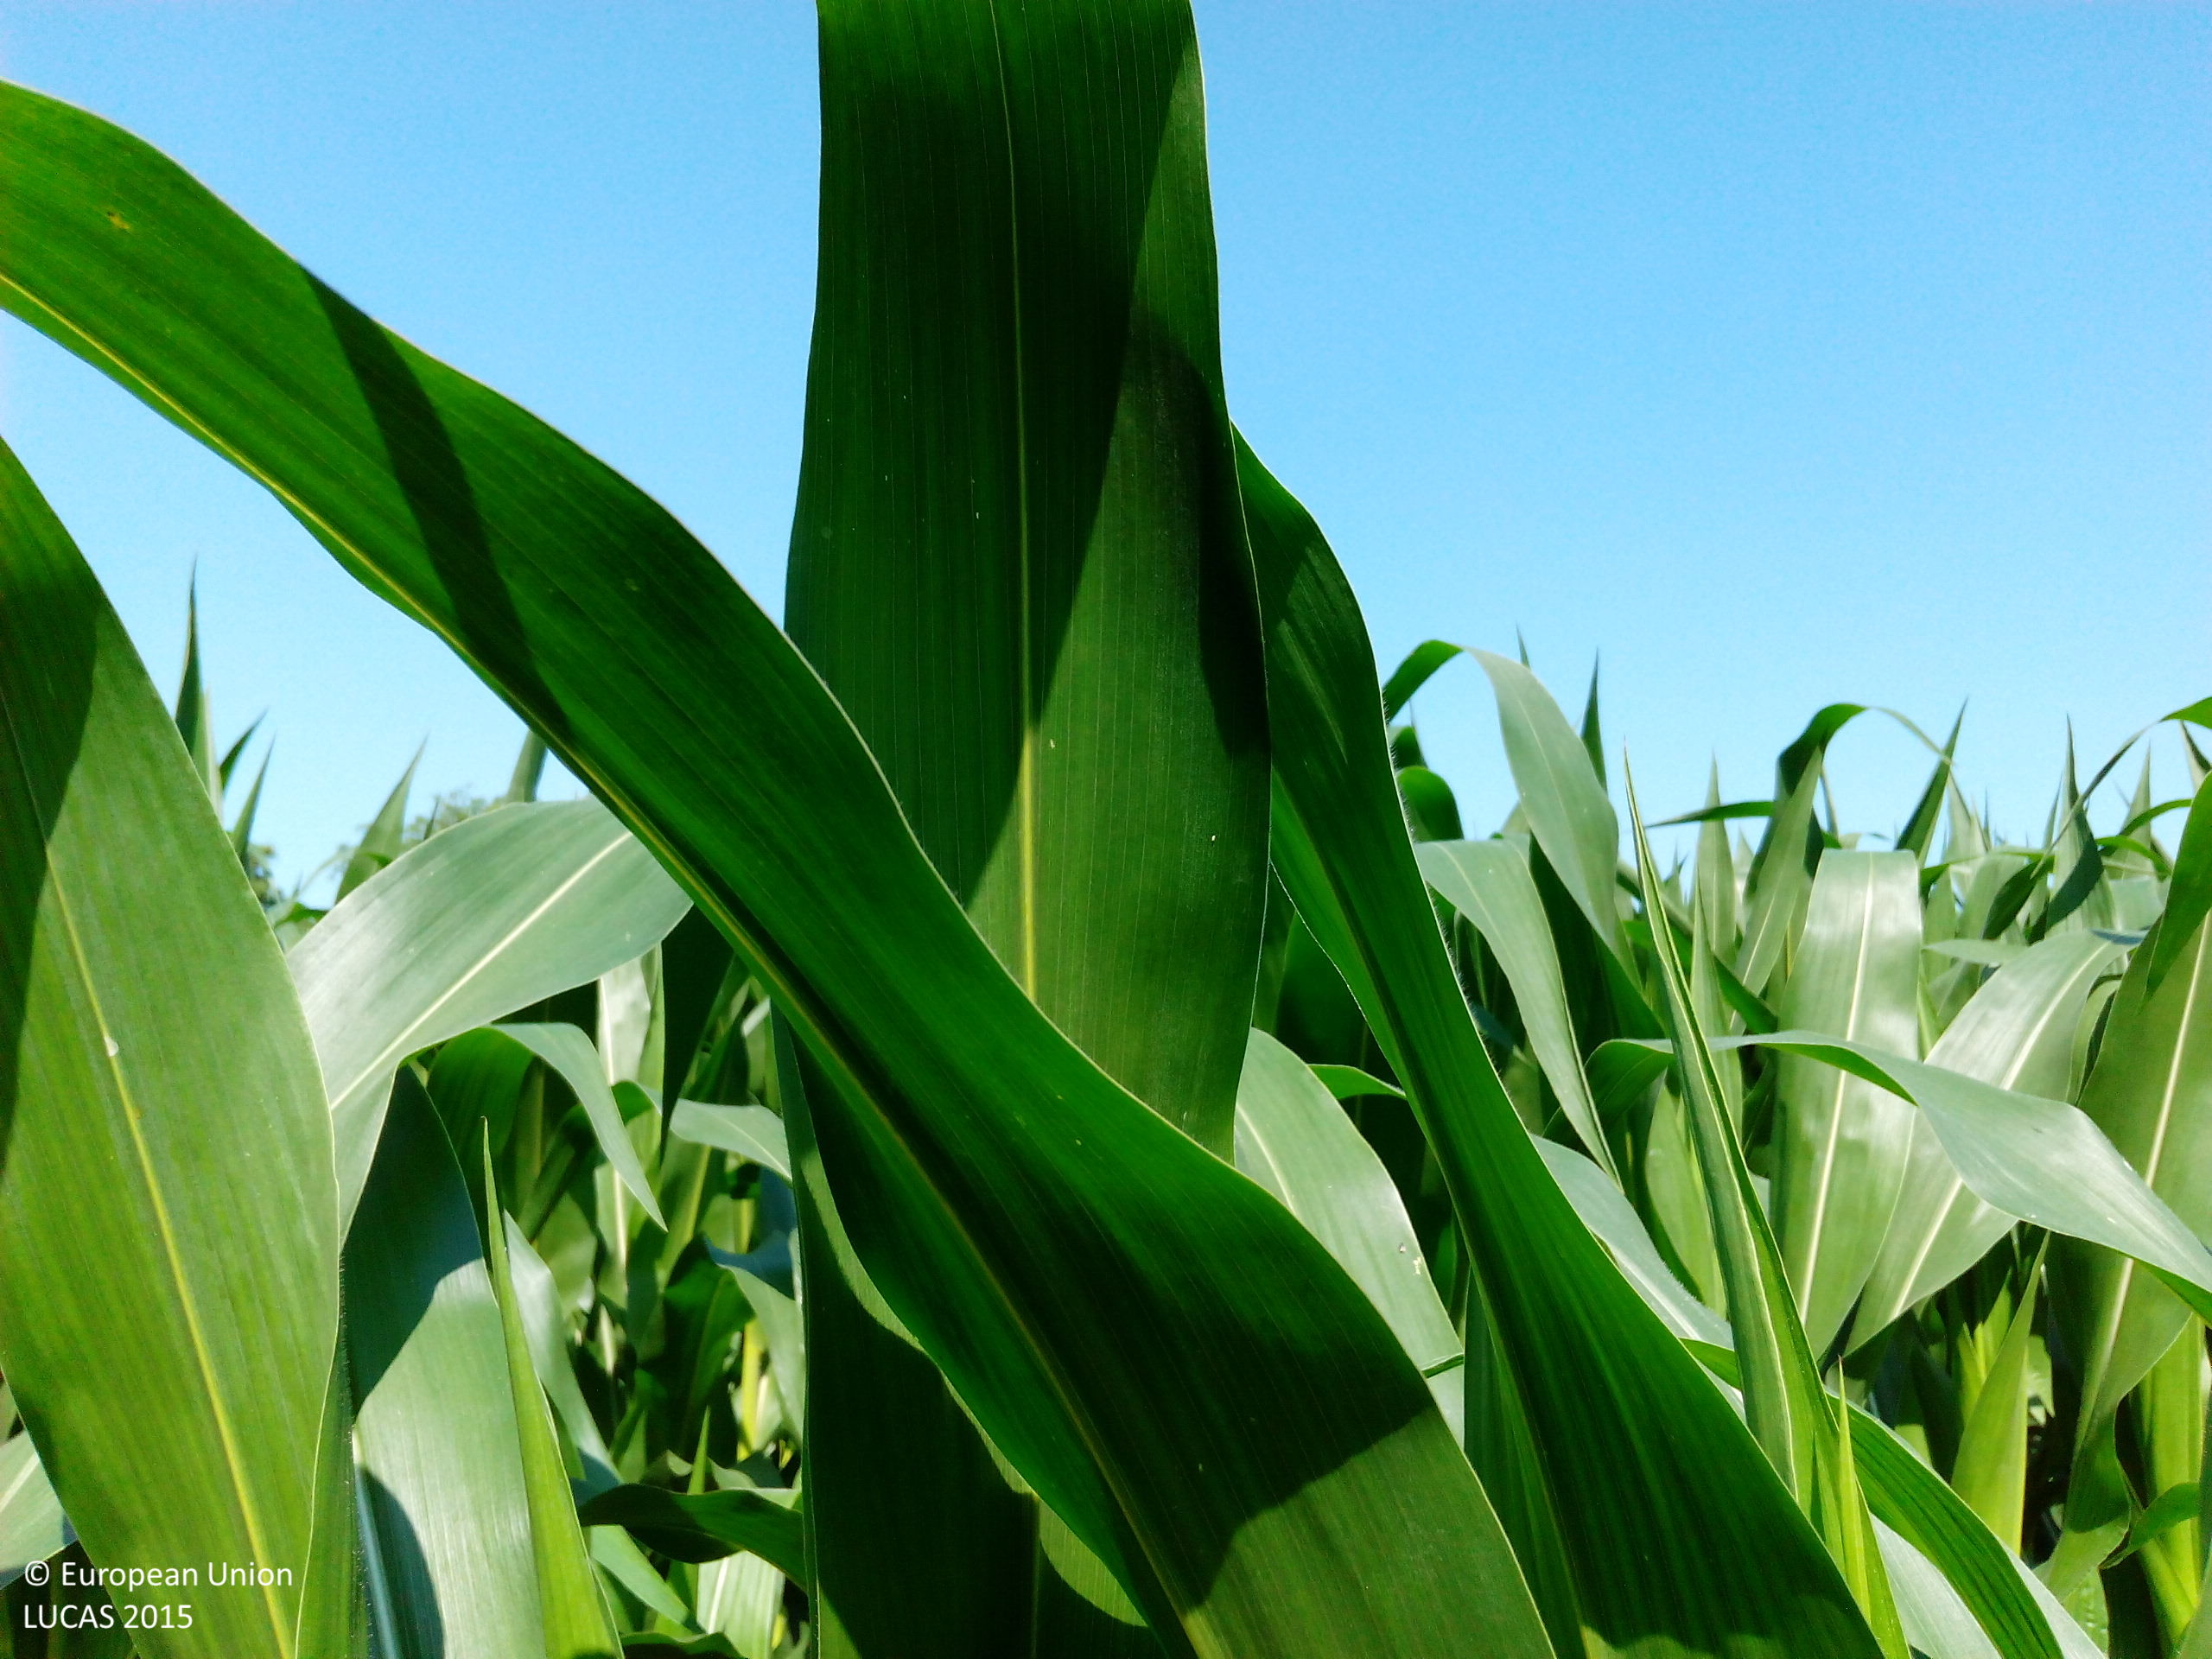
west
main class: Cropland
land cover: Maize
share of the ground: > 75 %
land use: Agriculture (excluding fallow land and kitchen gardens)
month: July
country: DE
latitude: 47.8381
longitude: 7.6364
